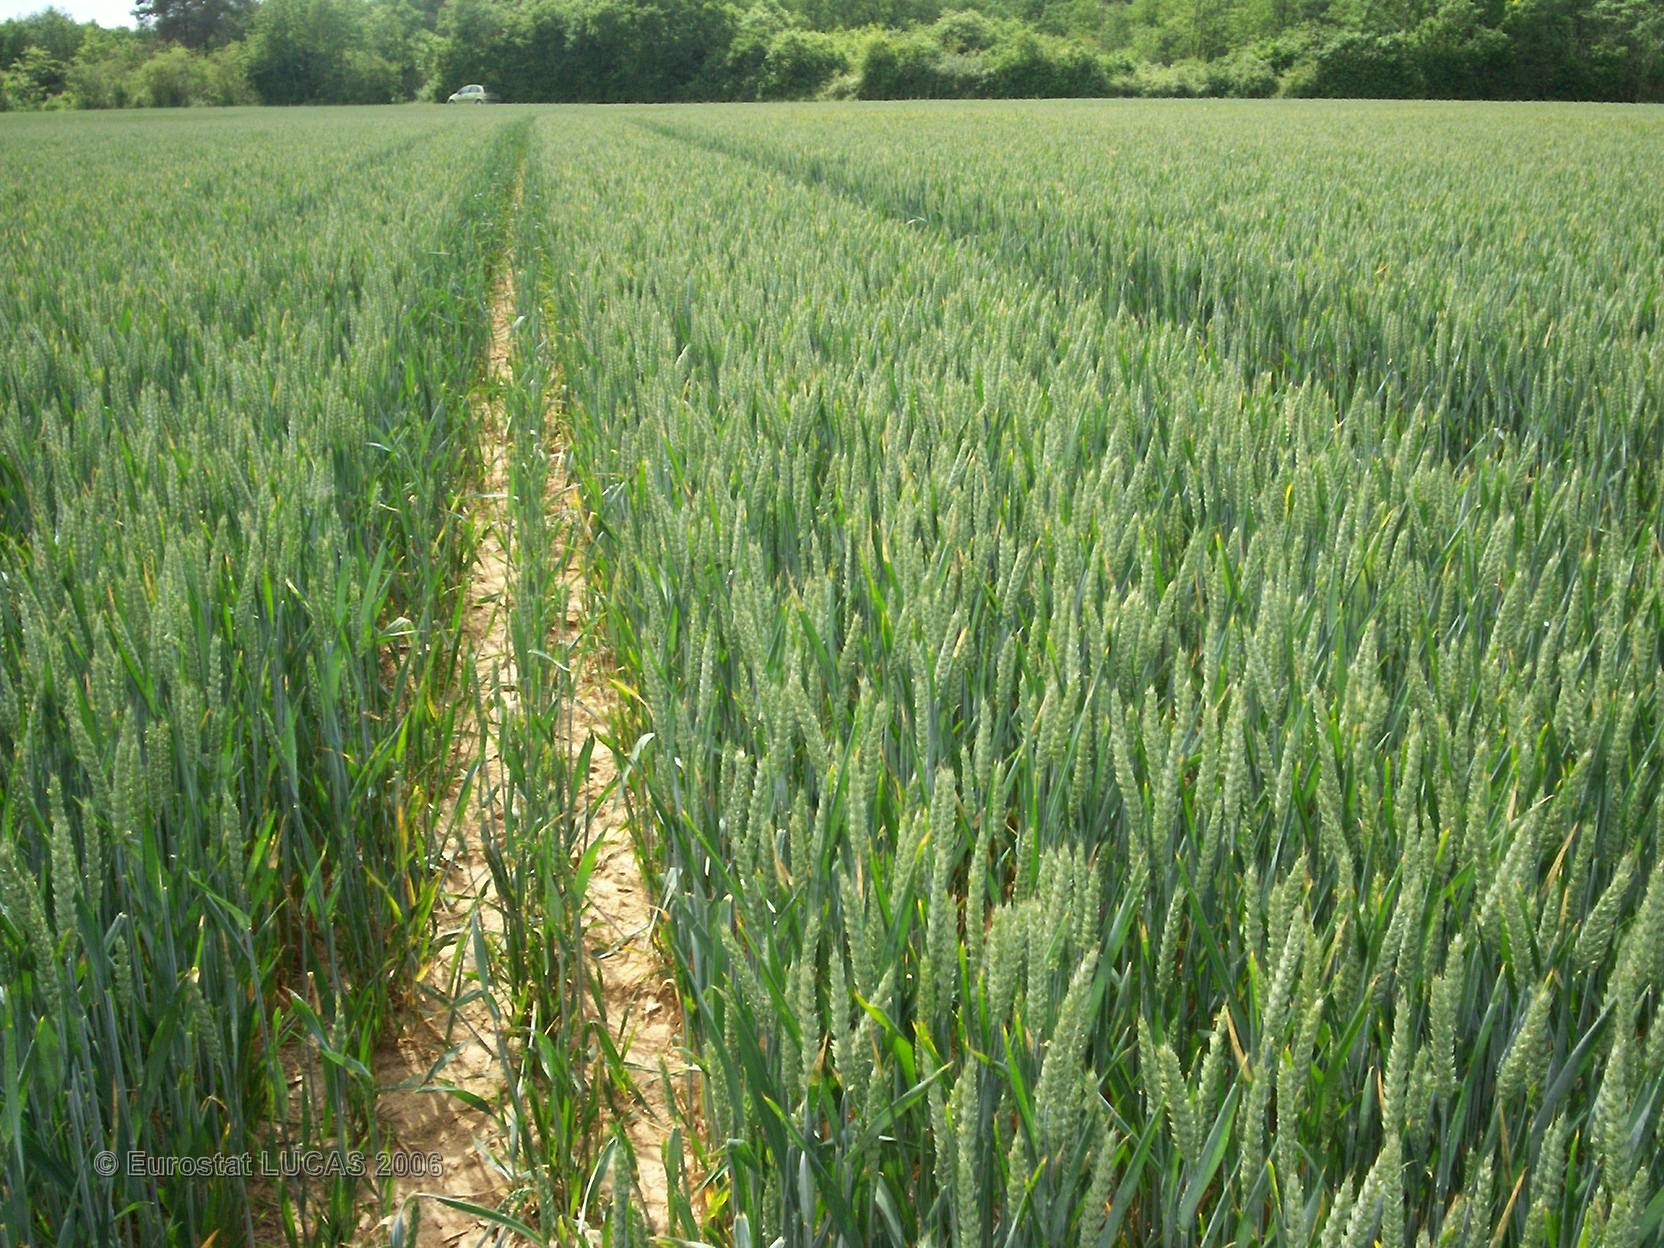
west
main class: Cropland
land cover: Common wheat
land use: Agriculture (excluding fallow land and kitchen gardens)
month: May
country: FR
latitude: 46.6045
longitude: 0.5699
